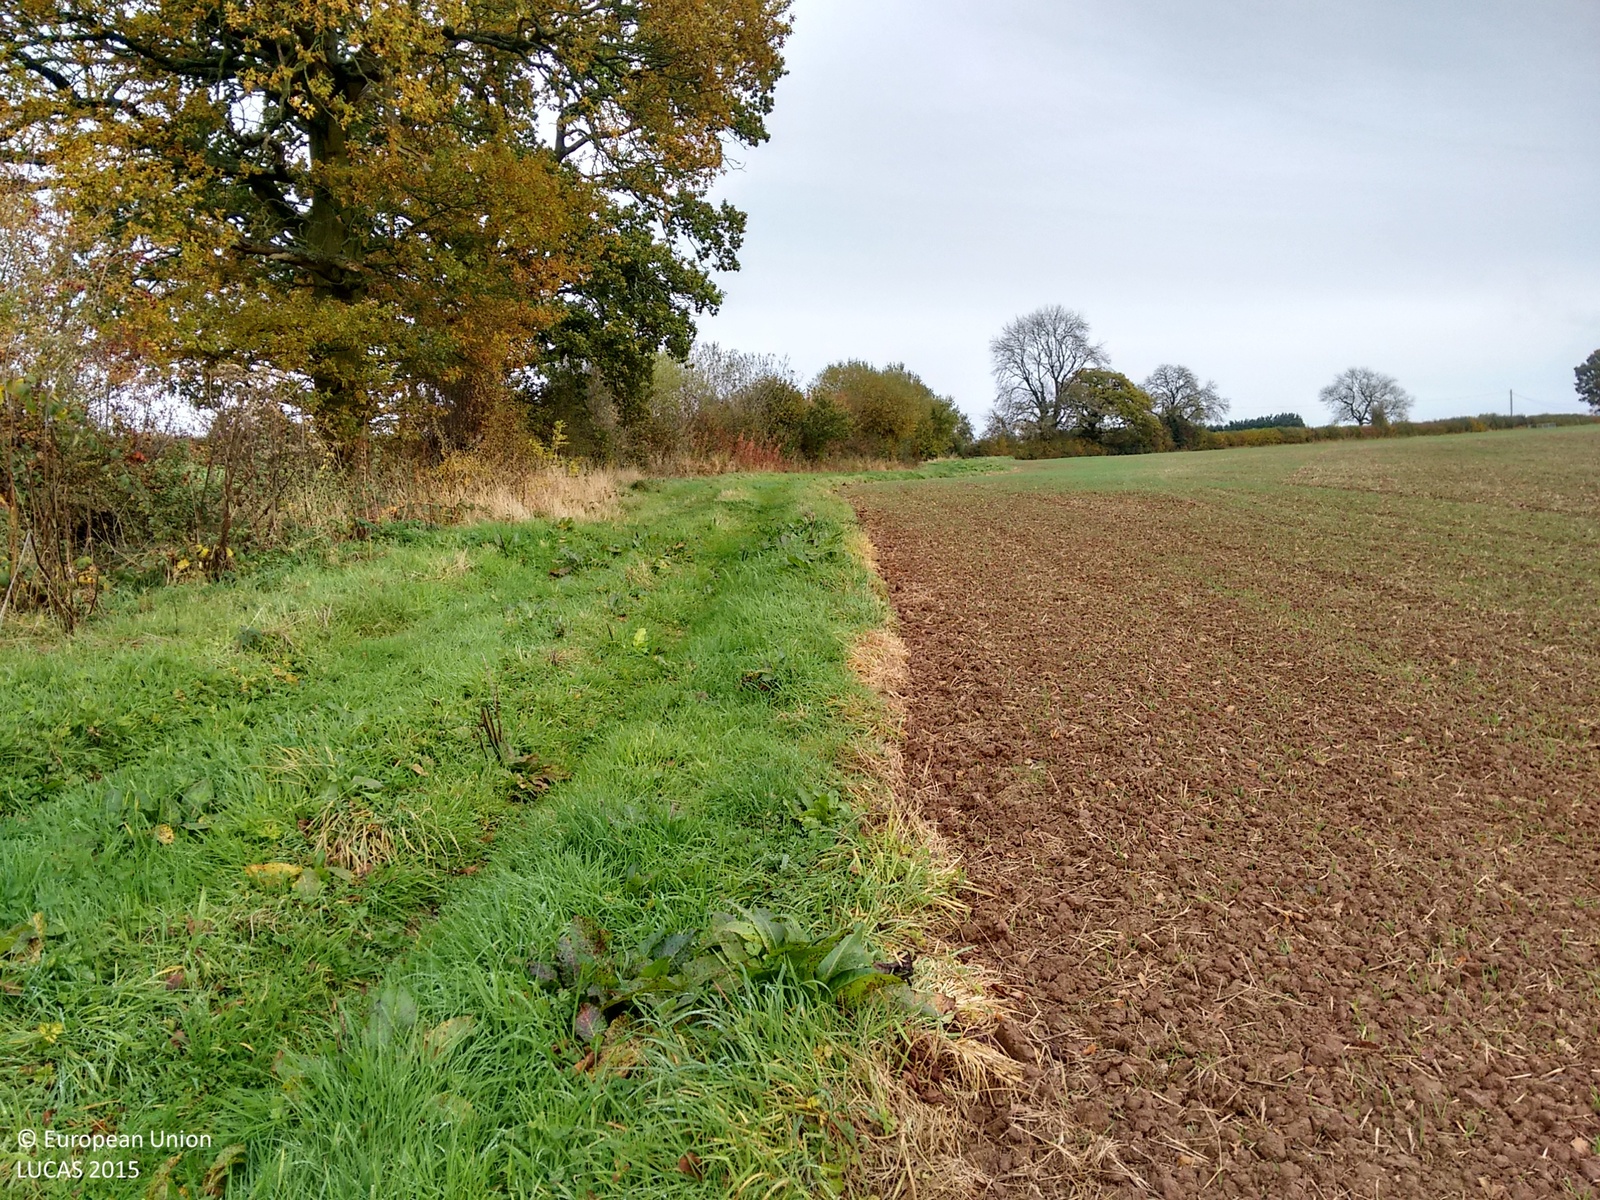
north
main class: Cropland
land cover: Common wheat
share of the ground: < 10 %
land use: Agriculture (excluding fallow land and kitchen gardens)
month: October
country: GB
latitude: 52.5094
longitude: -2.5467
